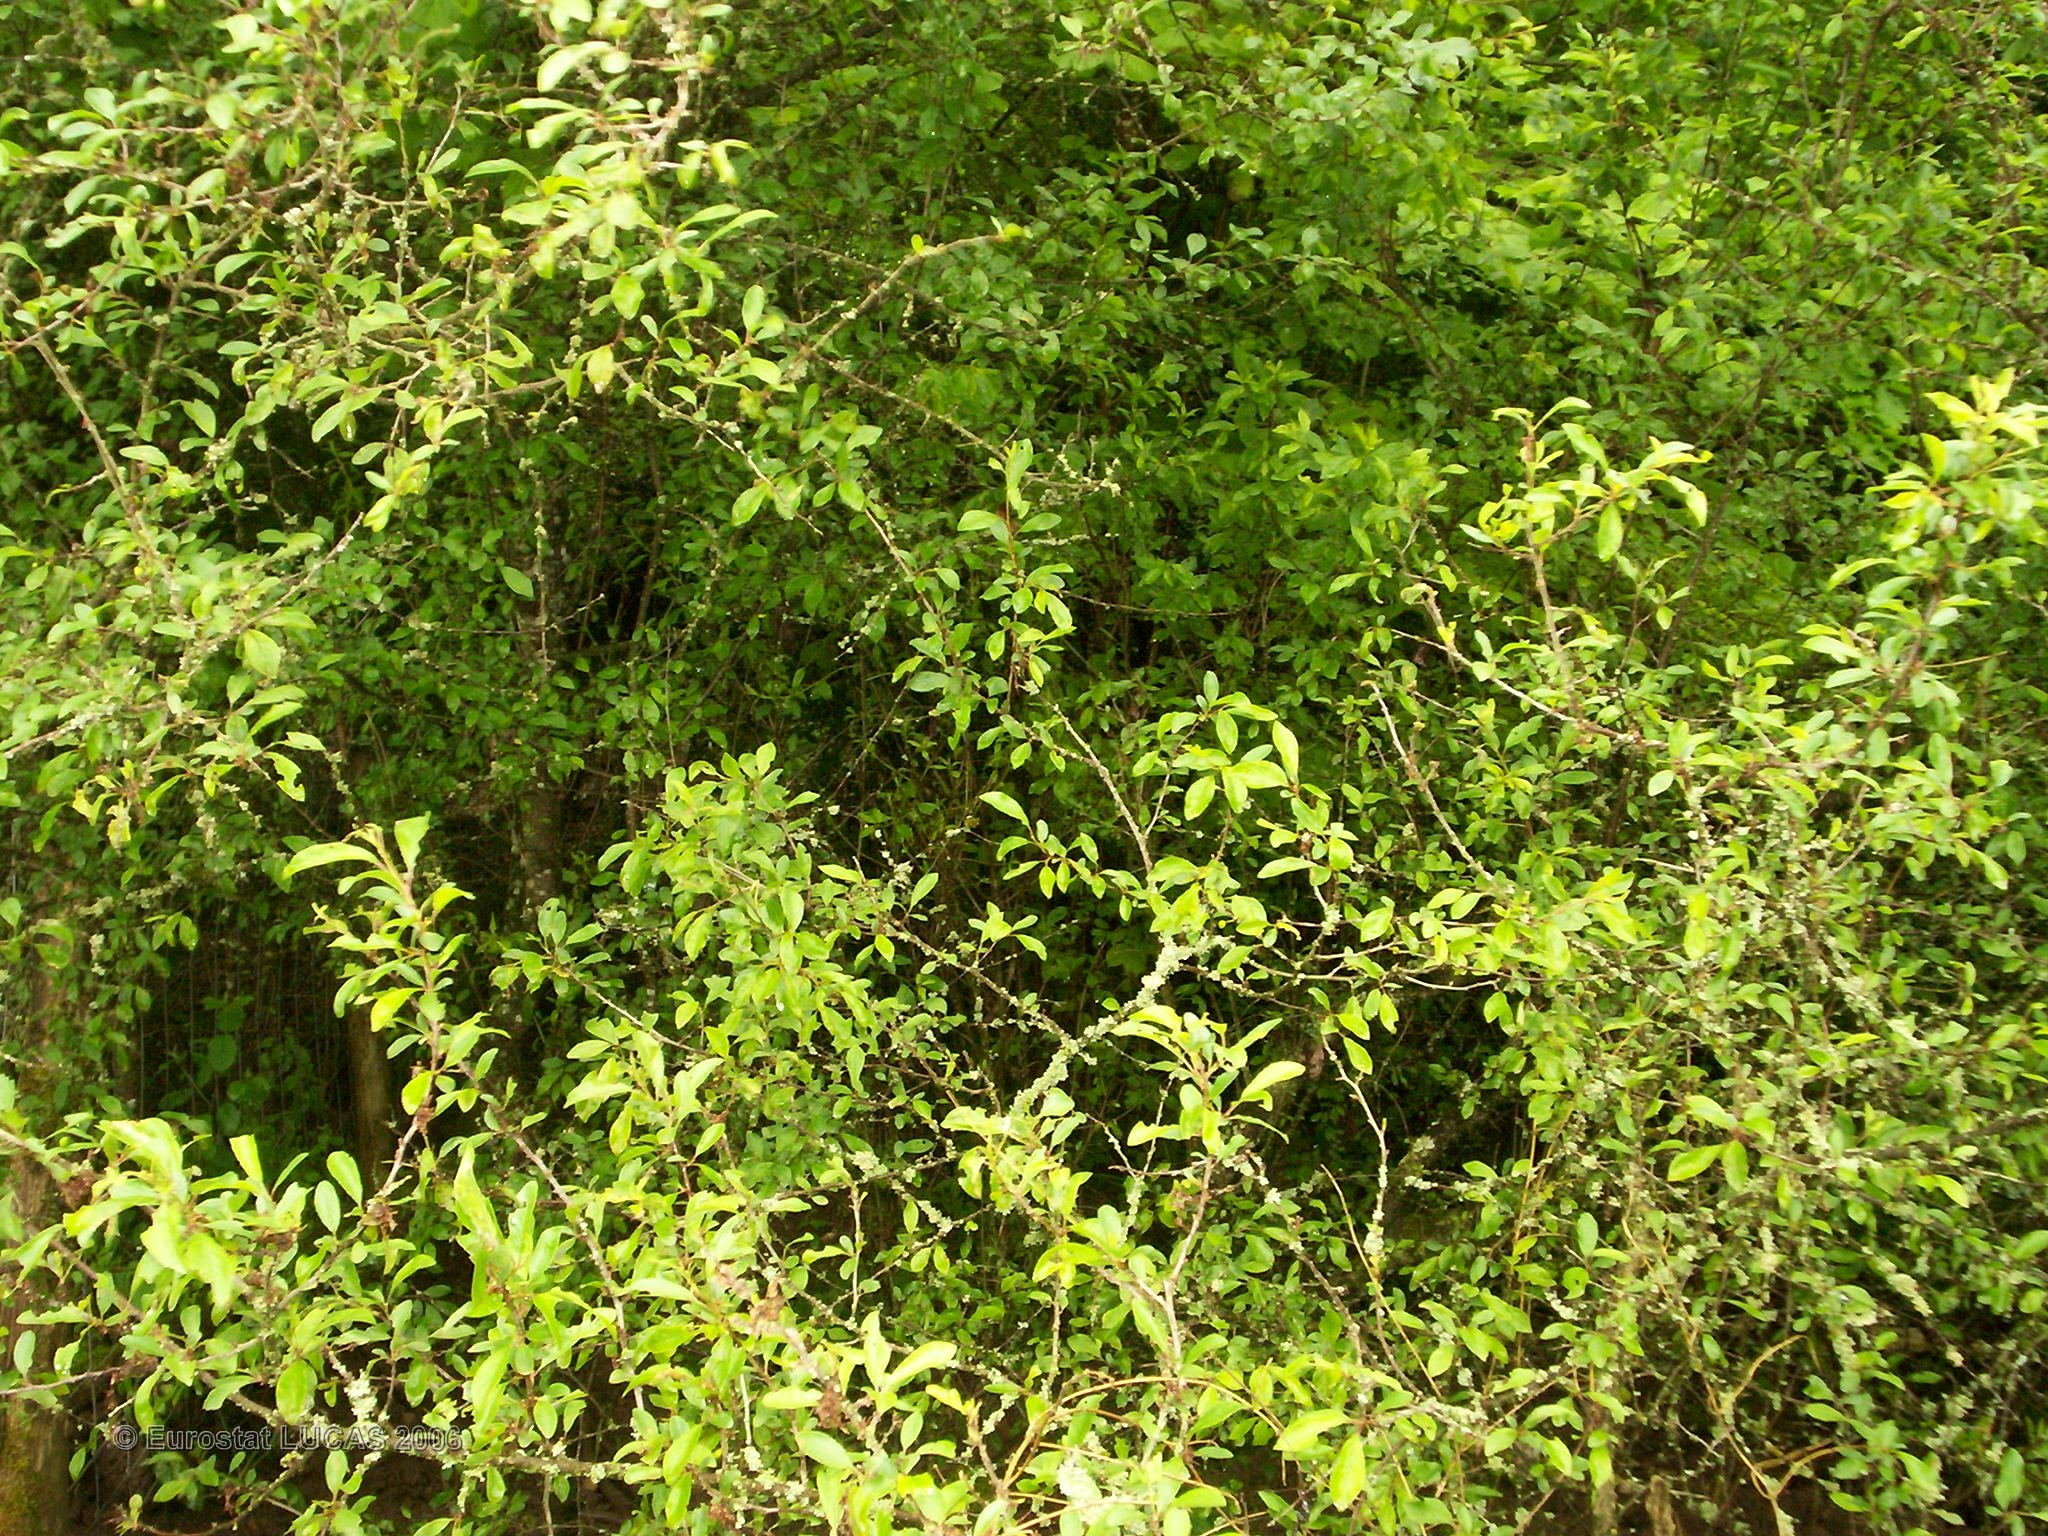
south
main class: Grassland
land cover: Grassland without tree/shrub cover
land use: Agriculture (excluding fallow land and kitchen gardens)
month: May
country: FR
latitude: 47.6553
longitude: 3.8591
